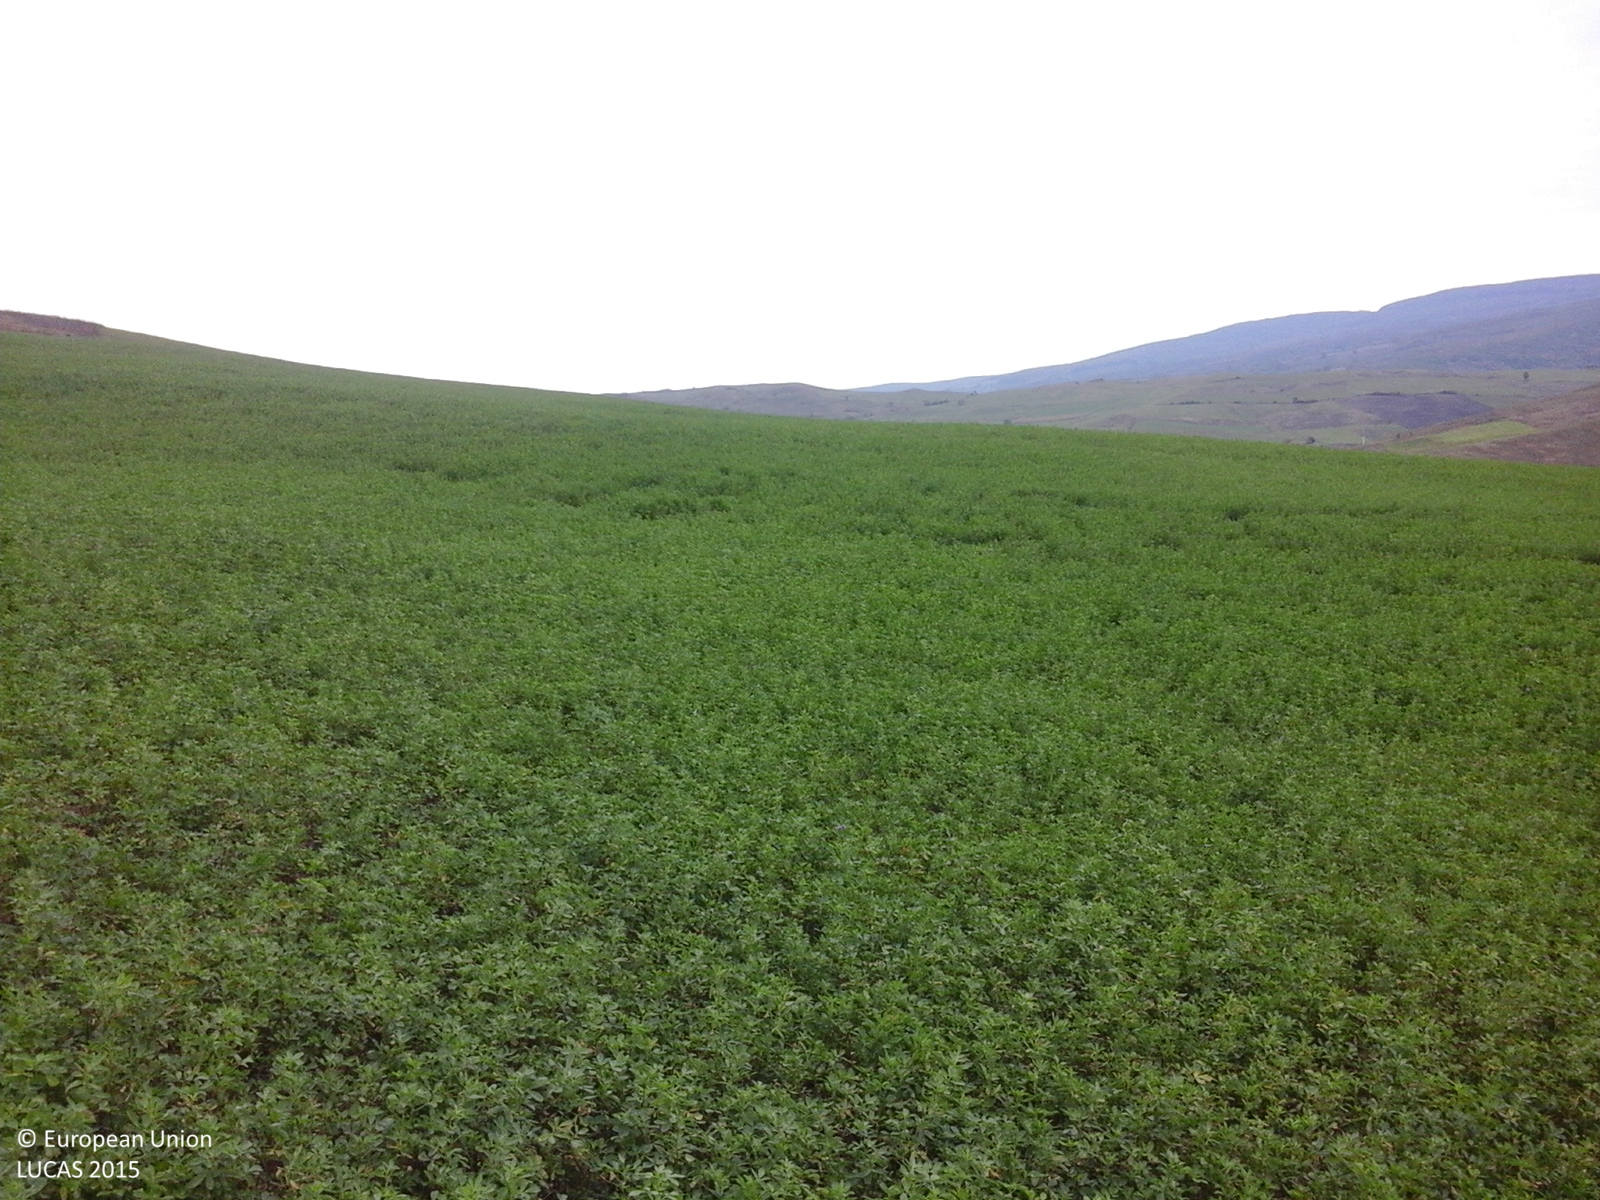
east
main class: Cropland
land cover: Lucerne
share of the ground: > 75 %
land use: Agriculture (excluding fallow land and kitchen gardens)
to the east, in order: Lucerne
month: October
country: RO
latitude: 46.3544
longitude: 25.0821
